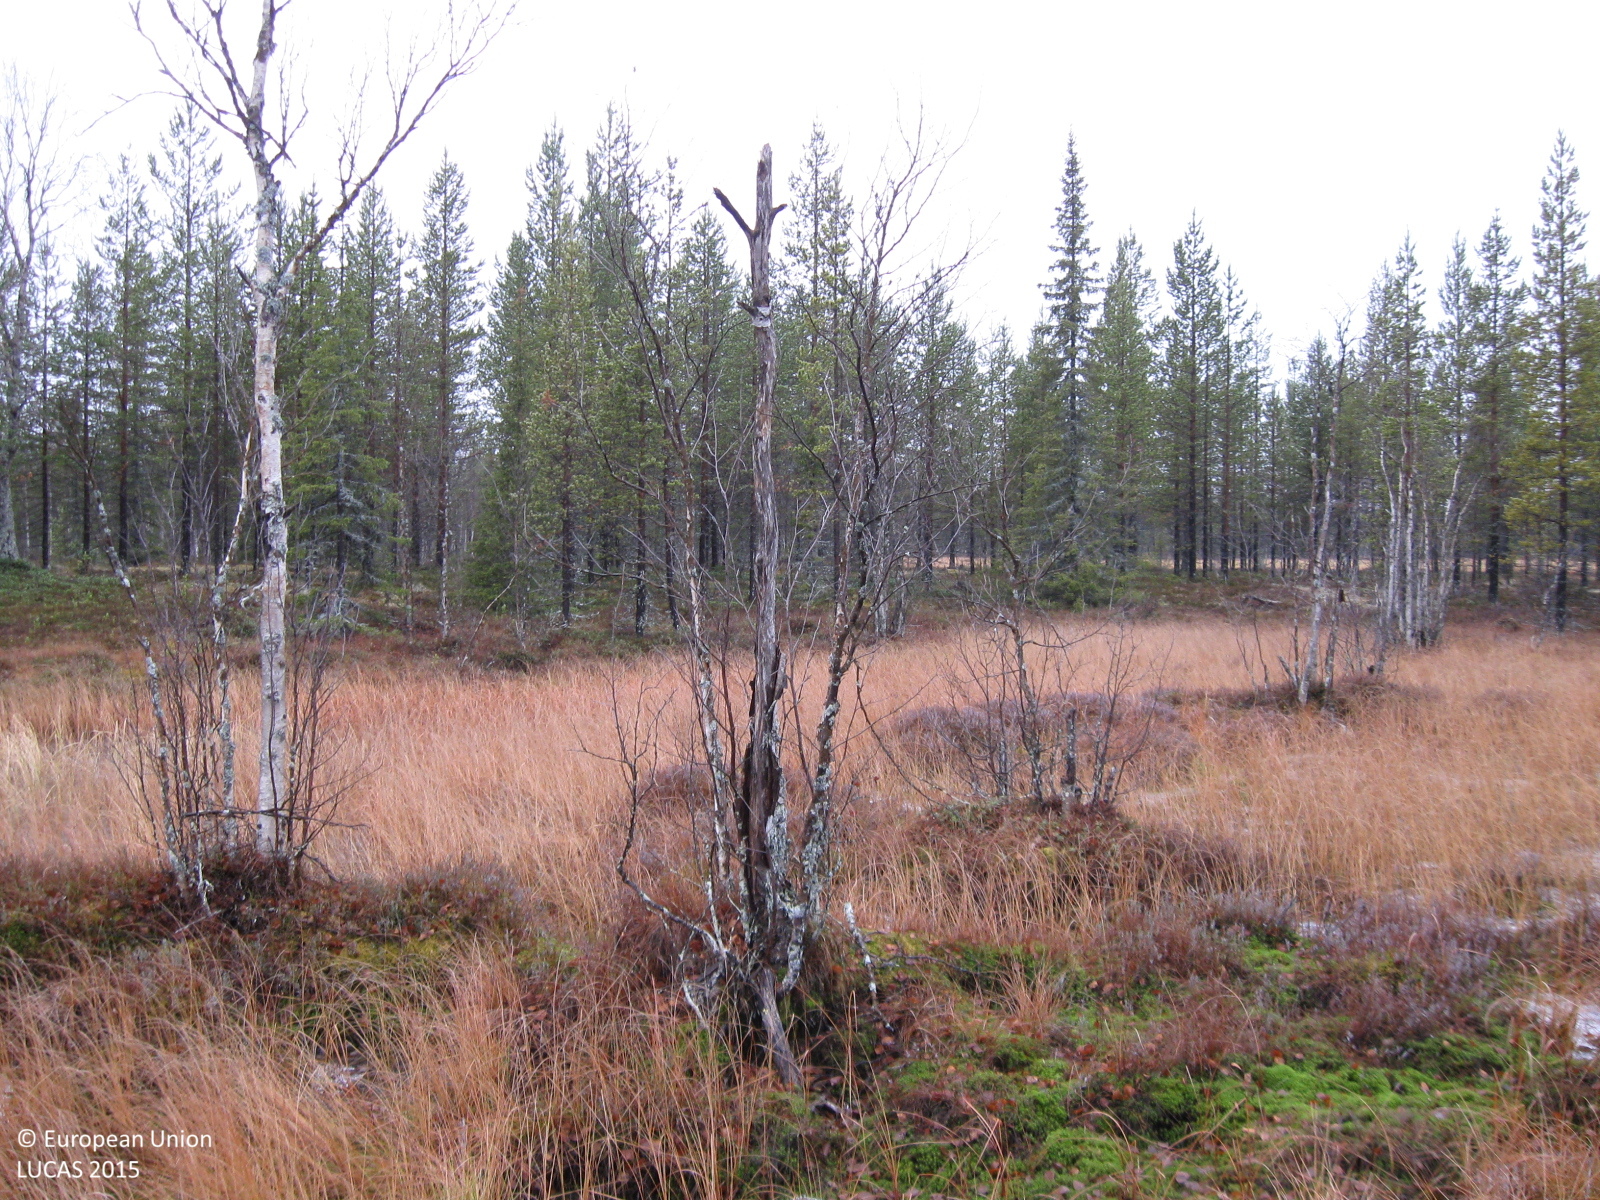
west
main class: Woodland
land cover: Pine dominated mixed woodland
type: mire and swamp forests
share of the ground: 25 - 50 %
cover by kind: herbaceous plants 35 %, shrubs 20 %, coniferous forest trees 15 %, broadleaved forest trees 15 %, lichens and mosses 15 %
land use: Semi-natural and natural areas not in use
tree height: > 5 m
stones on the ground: < 10 %
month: October
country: SE
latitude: 66.7399
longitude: 21.0074
